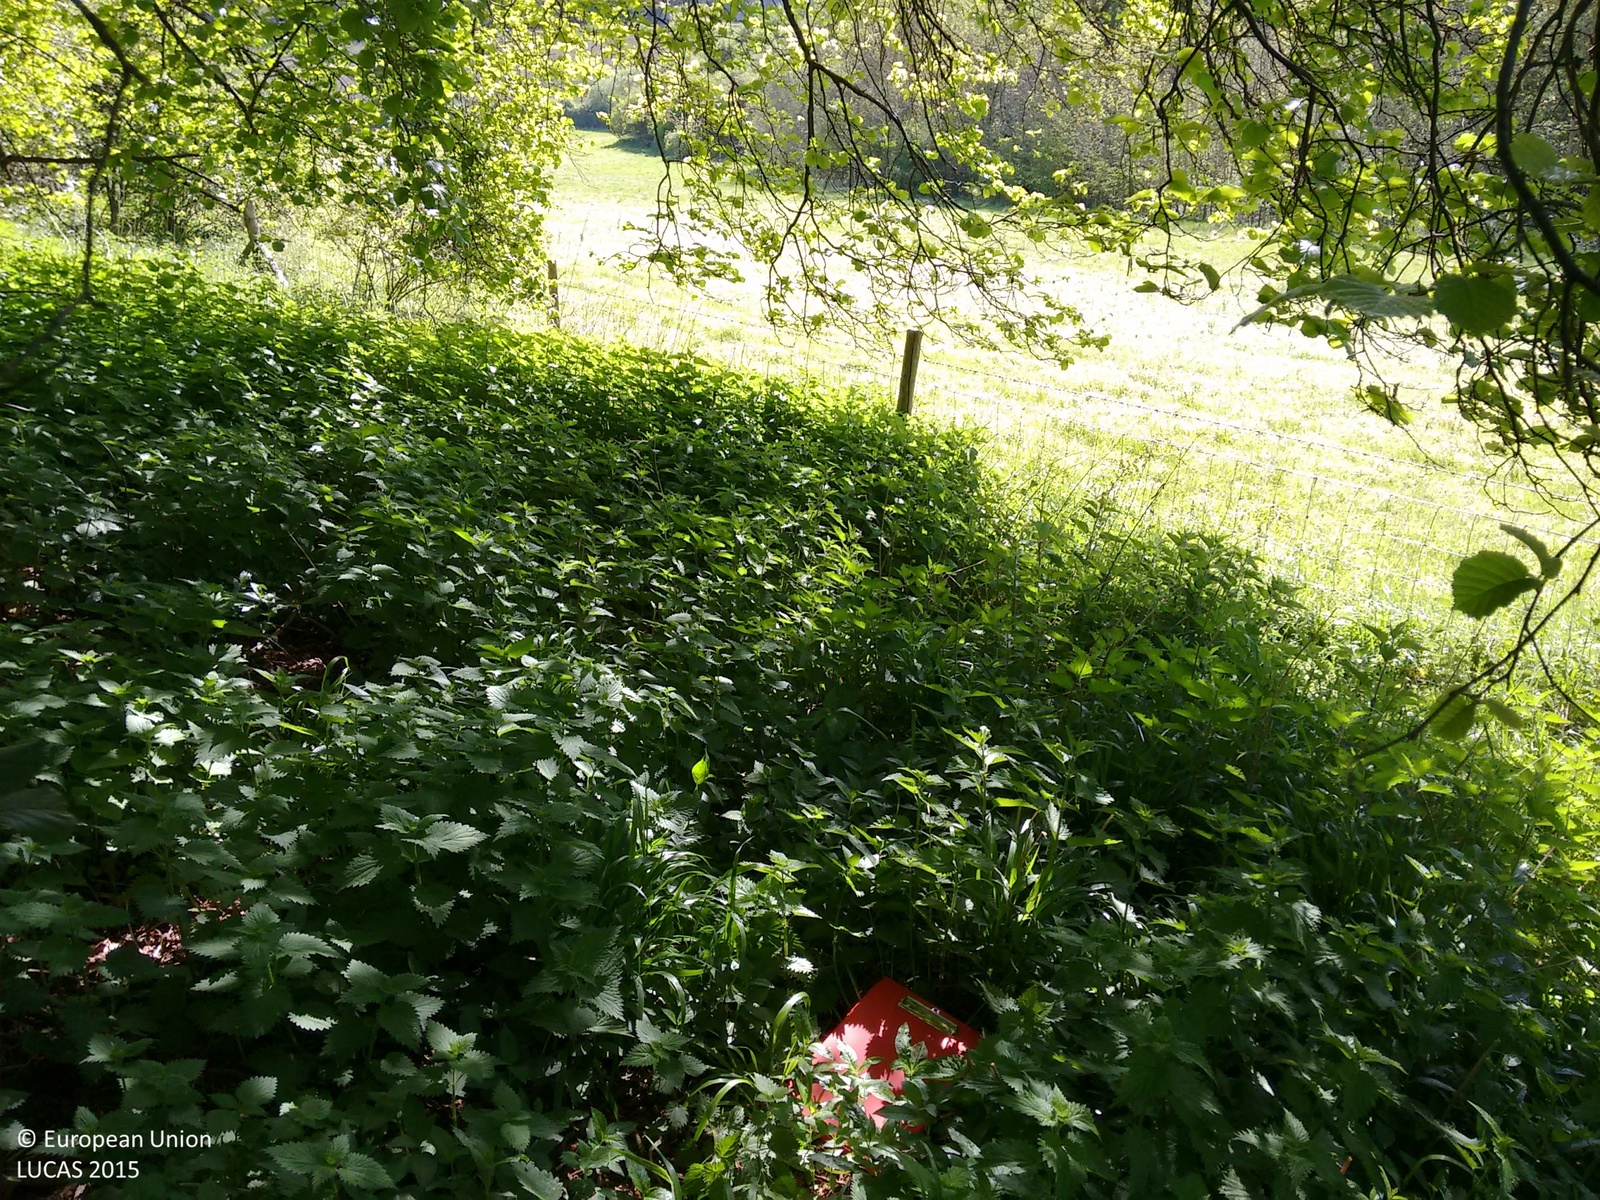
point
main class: Woodland
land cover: Broadleaved woodland
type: mesophytic deciduous forest
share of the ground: > 75 %
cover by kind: broadleaved forest trees 80 %, herbaceous plants 20 %
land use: Semi-natural and natural areas not in use
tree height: > 5 m
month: May
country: GB
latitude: 51.9520
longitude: -0.4410
